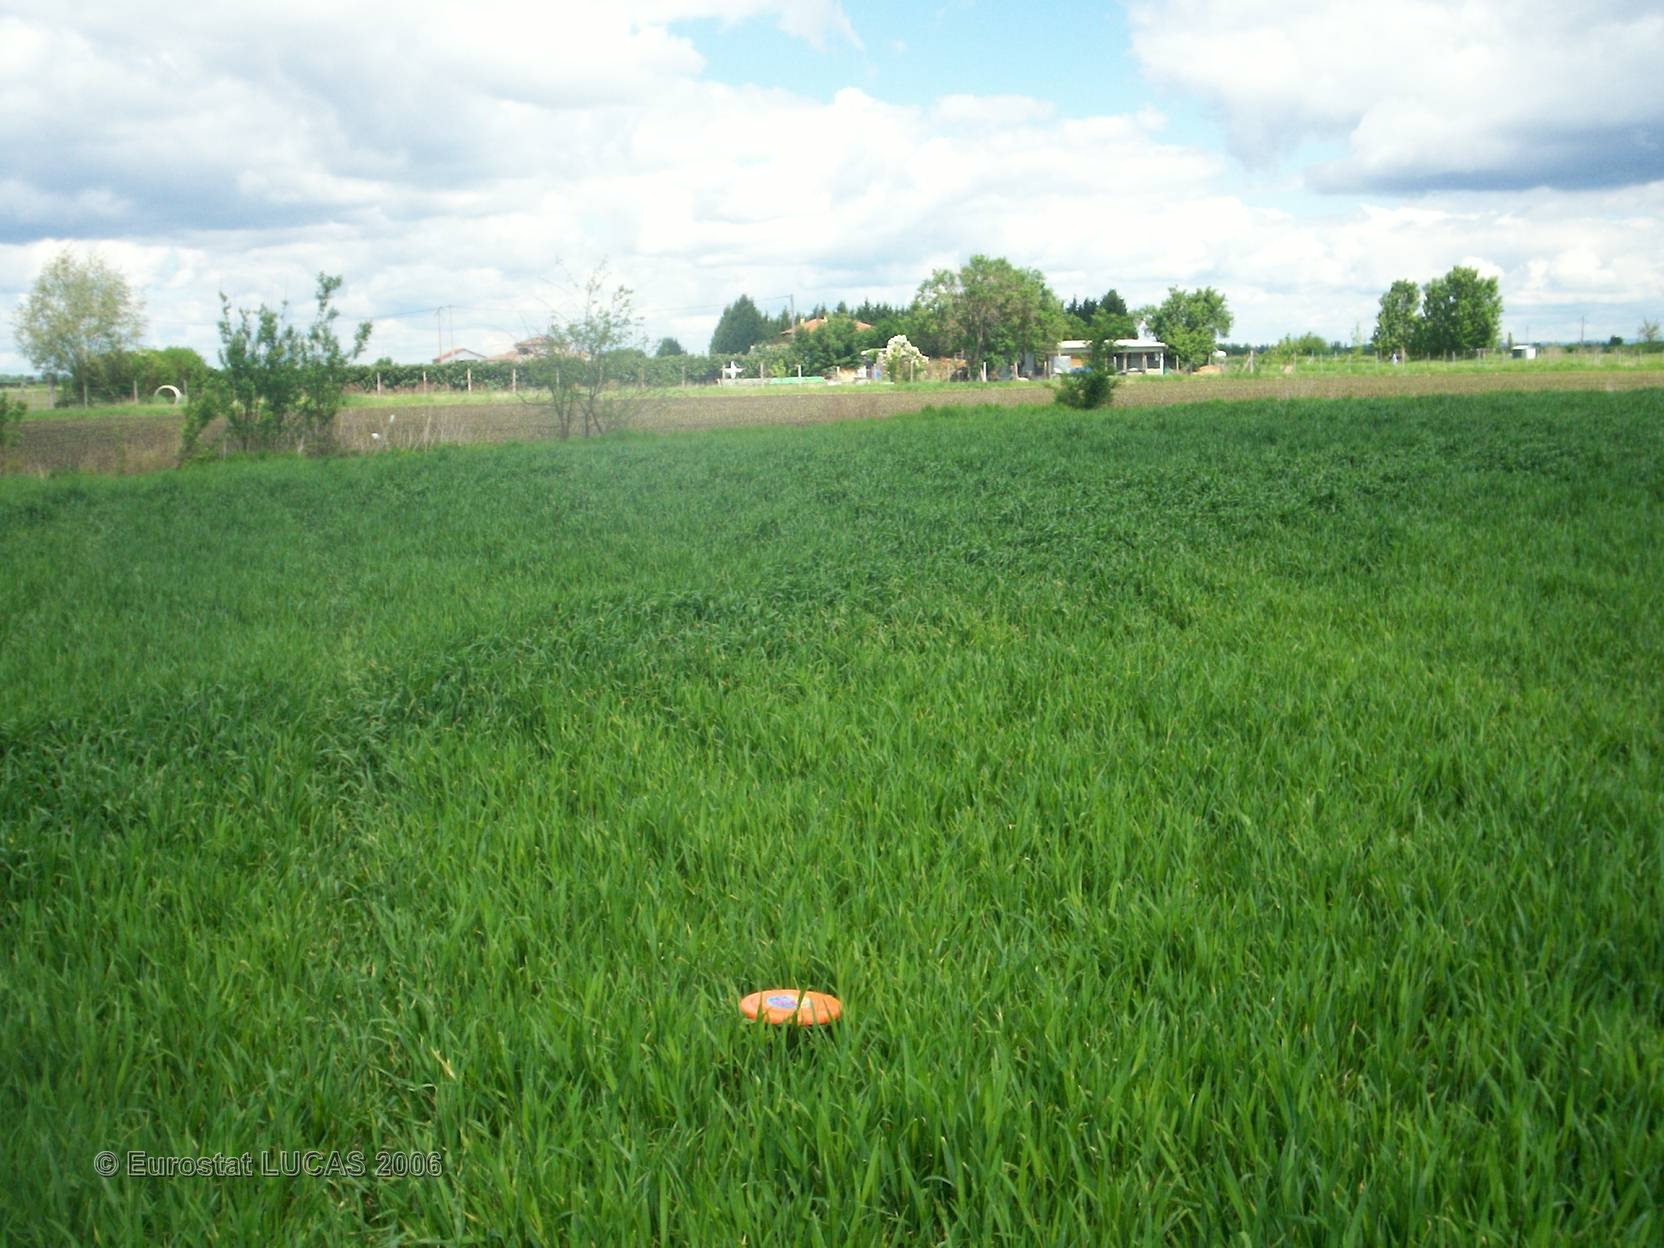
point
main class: Cropland
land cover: Triticale
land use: Agriculture (excluding fallow land and kitchen gardens)
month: May
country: FR
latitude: 45.8448
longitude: 3.1882
